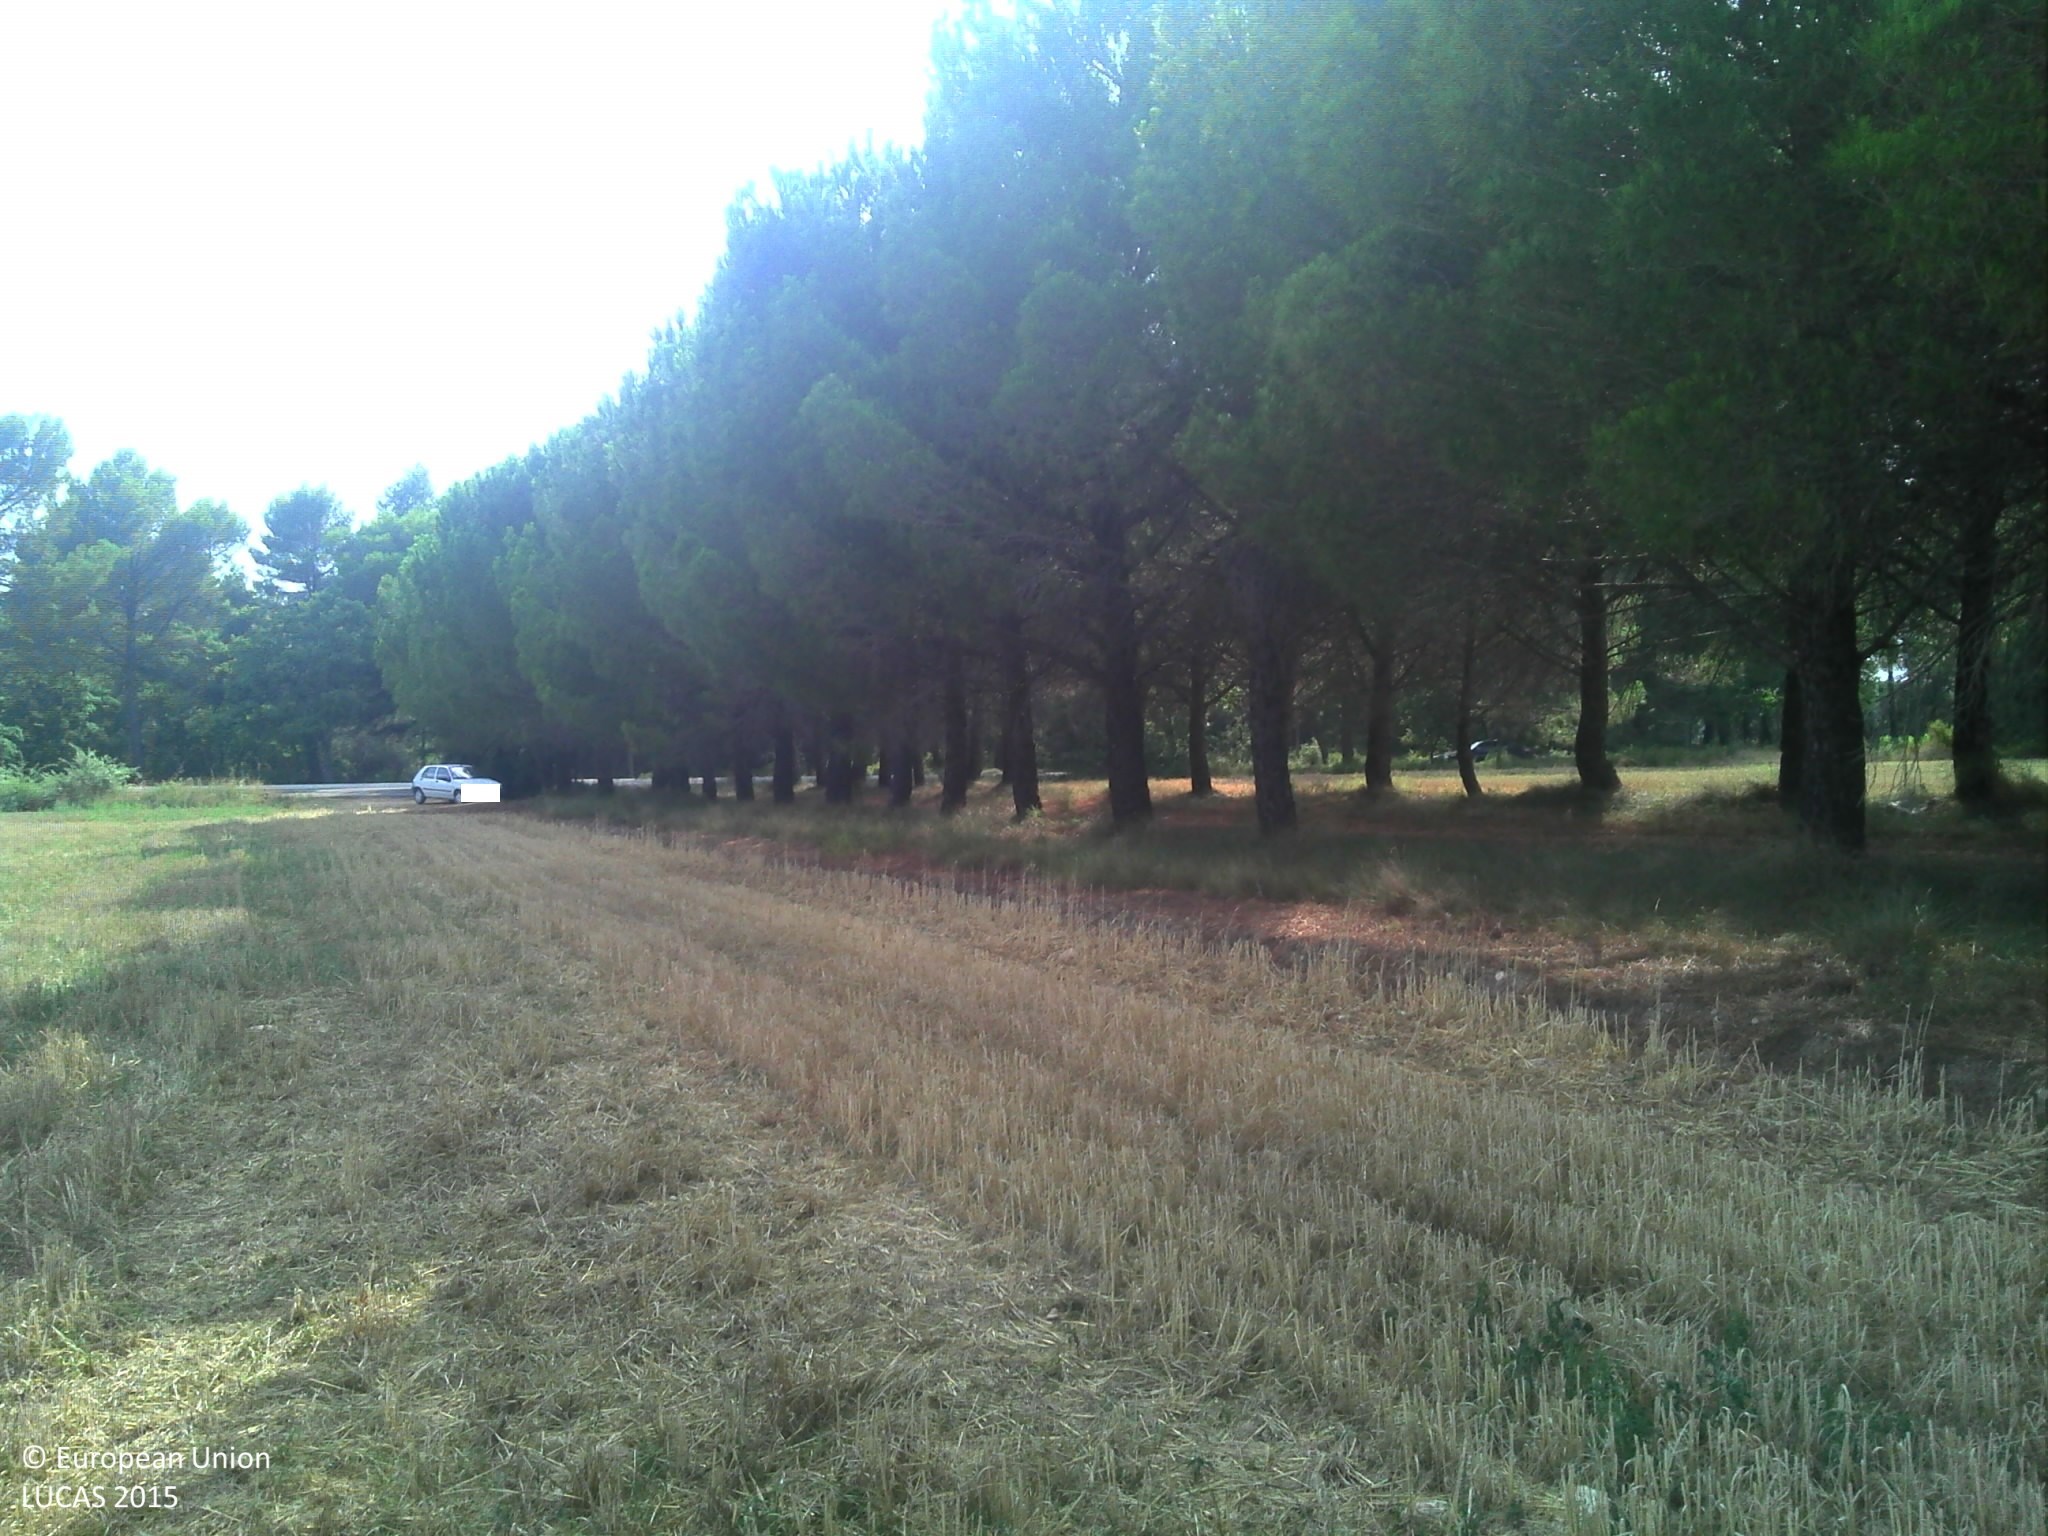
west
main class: Cropland
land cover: Durum wheat
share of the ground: > 75 %
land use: Agriculture (excluding fallow land and kitchen gardens)
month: August
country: FR
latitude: 43.6146
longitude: 5.3629
